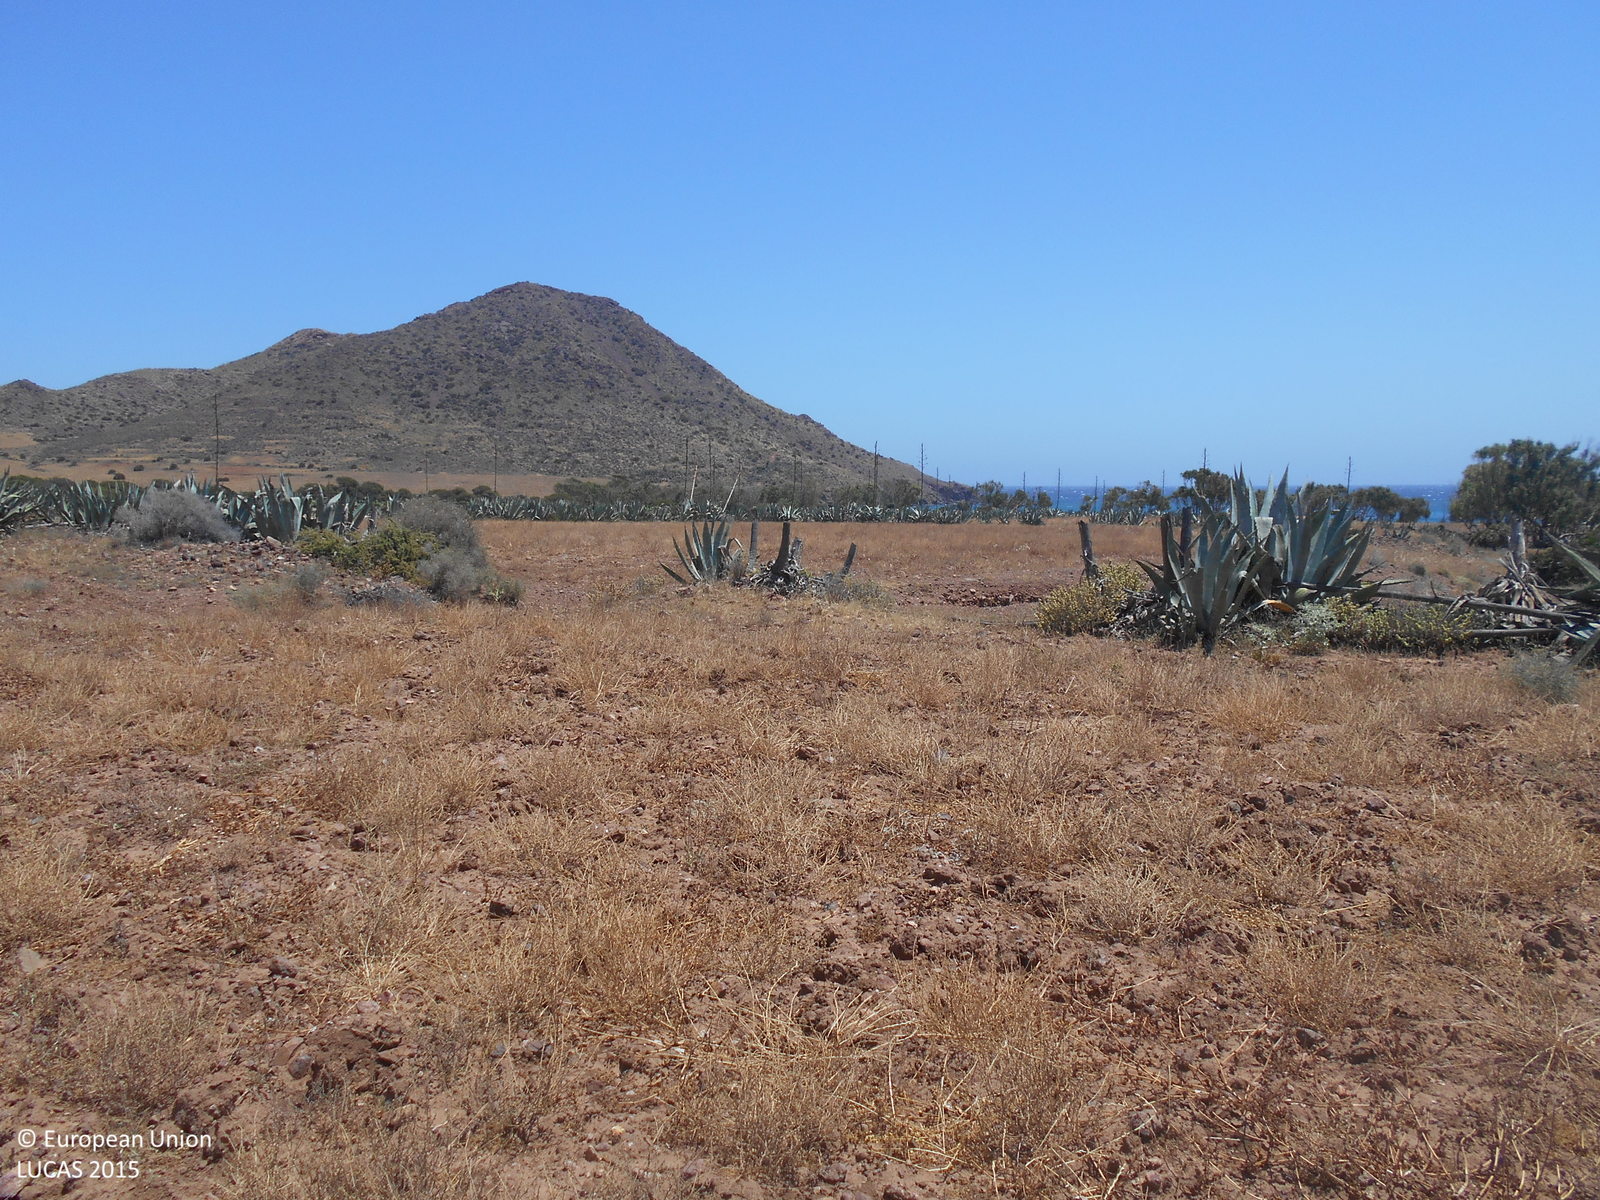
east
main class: Grassland
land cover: Grassland without tree/shrub cover
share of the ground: 25 - 50 %
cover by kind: unconsolidated bare surface 70 %, herbaceous plants 30 %
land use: Abandoned areas
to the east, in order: Grassland without tree/shrub cover; Shruby margins; Grassland without tree/shrub cover; Shruby margins; Grassland without tree/shrub cover; Shruby margins; Tracks; Shruby margins; Grassland without tree/shrub cover; Shruby margins; Grassland without tree/shrub cover; Shruby margins; Grassland without tree/shrub cover; Shruby margins; Grassland without tree/shrub cover; Shruby margins; Grassland without tree/shrub cover; Shruby margins; Tracks; Grassland without tree/shrub cover; Shrubland without tree cover
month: May
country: ES
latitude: 36.7488
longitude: -2.1242
